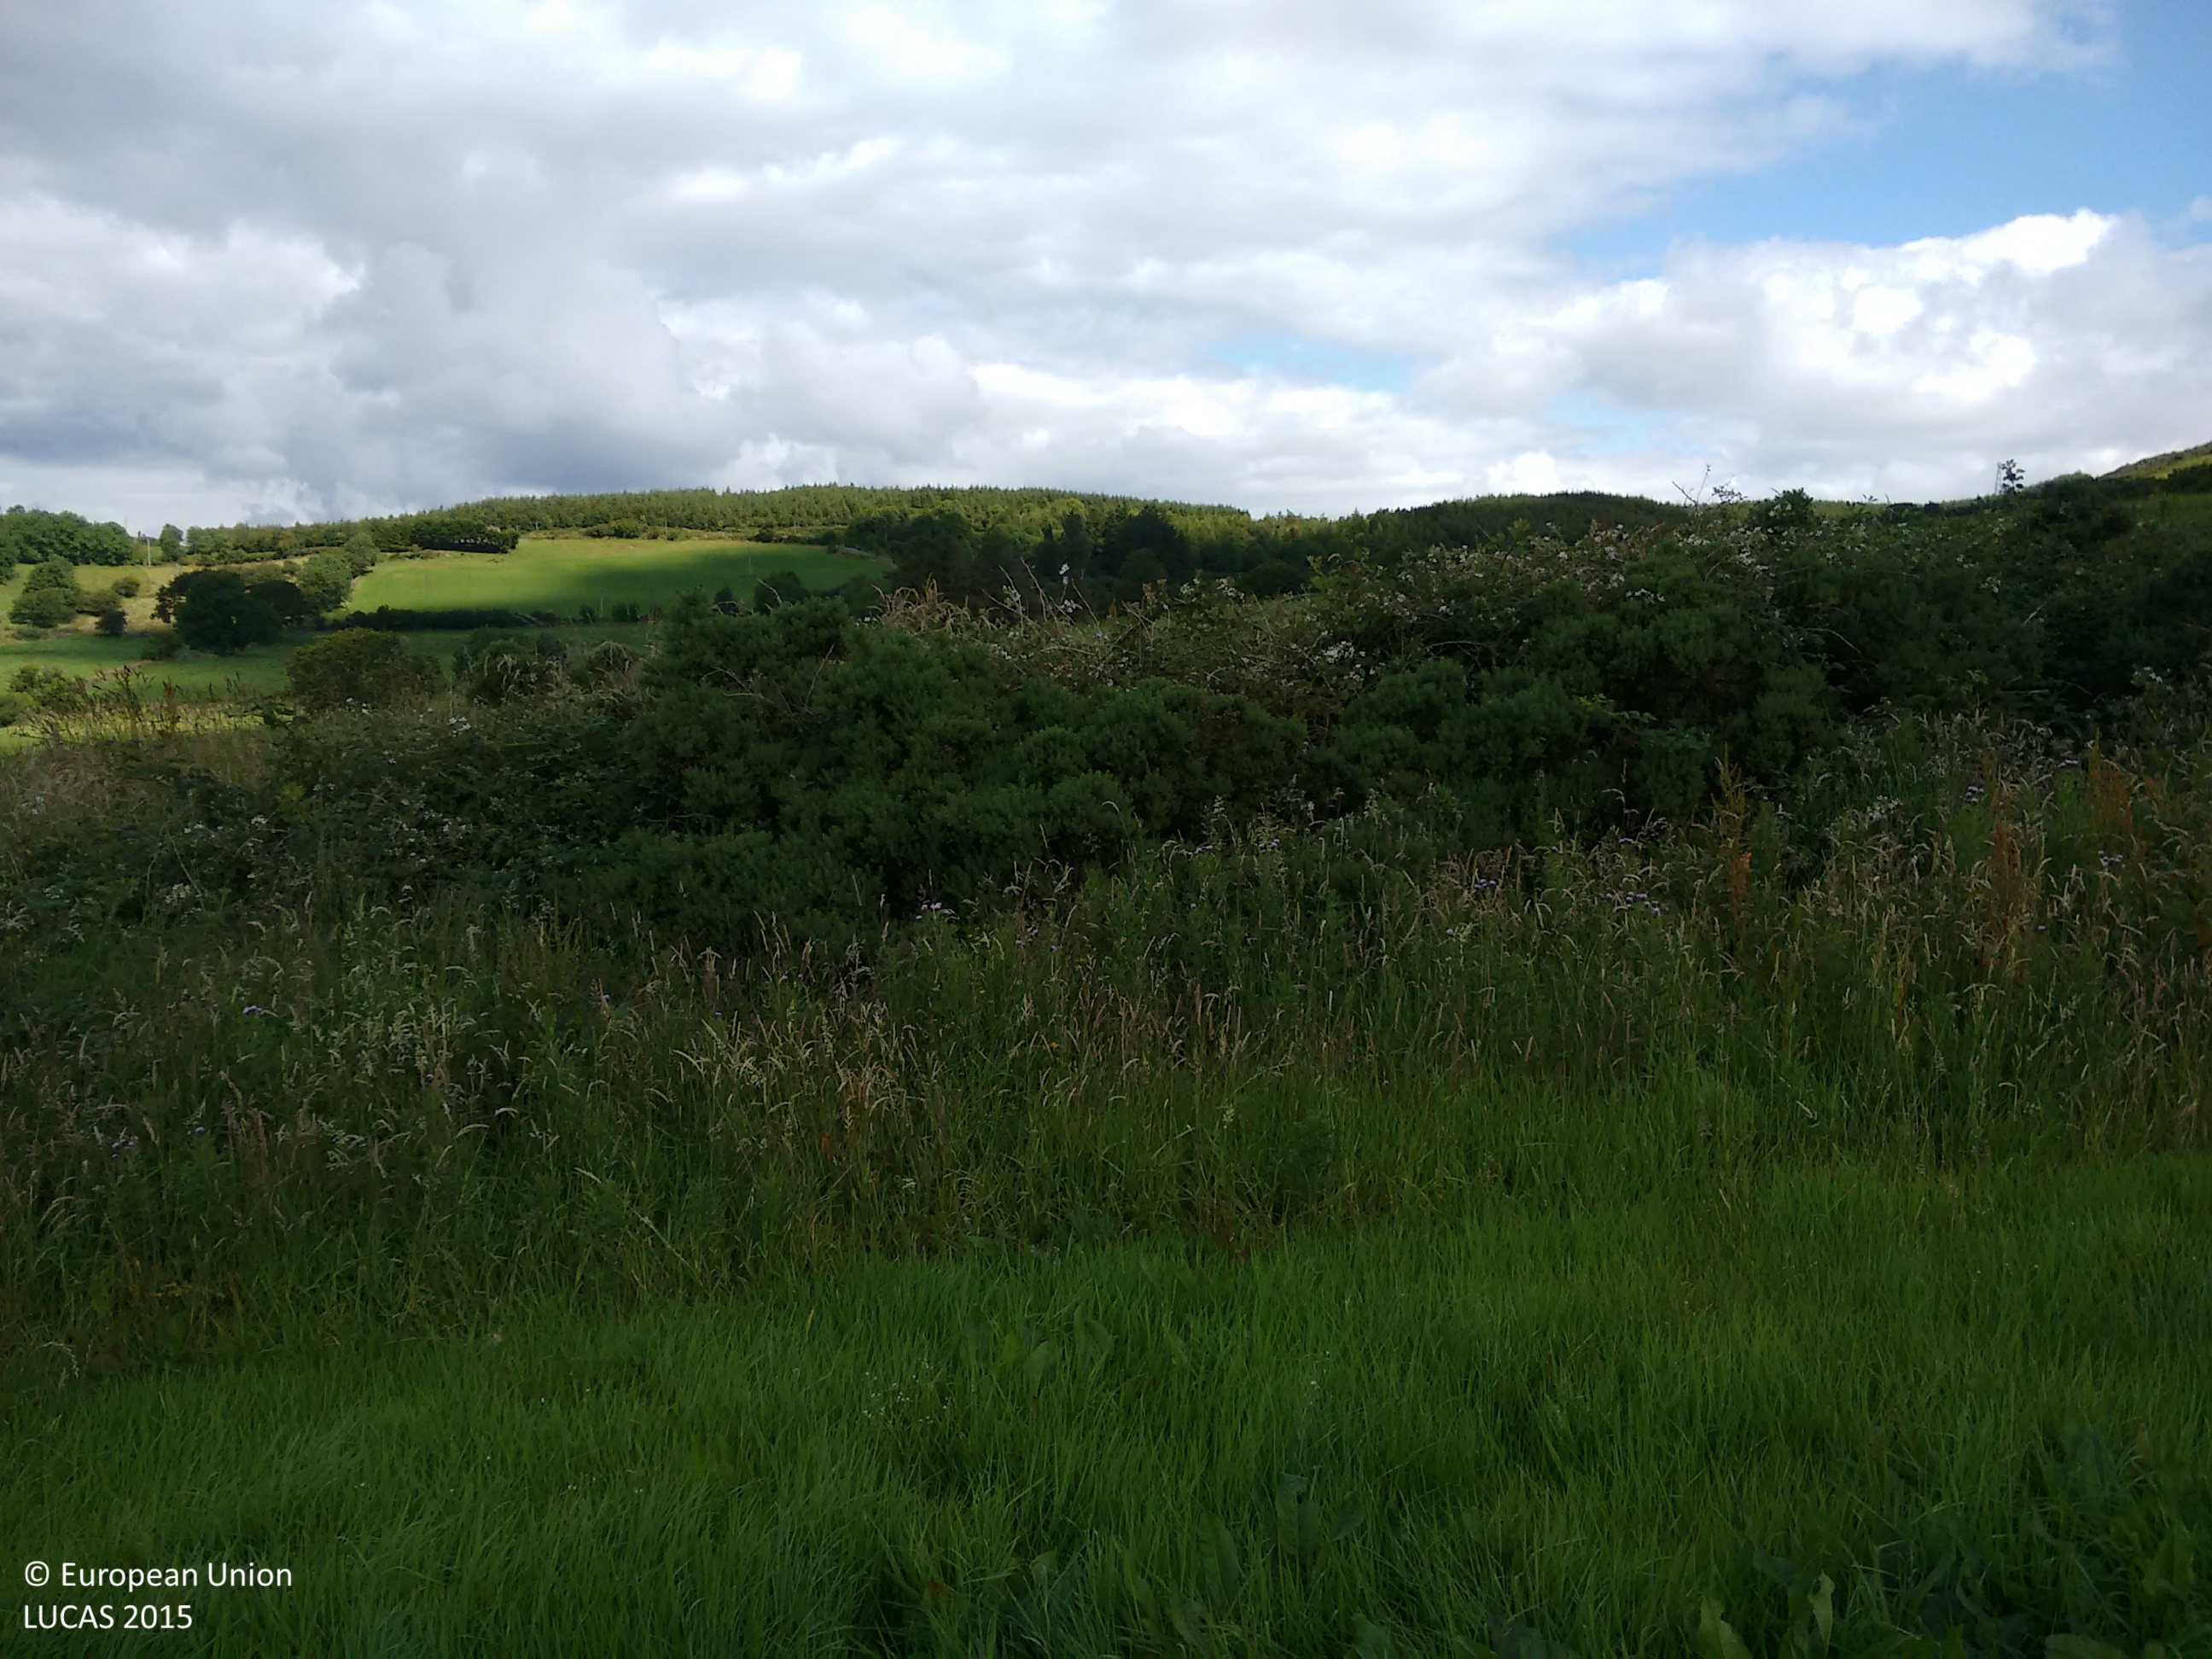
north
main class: Grassland
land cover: Grassland without tree/shrub cover
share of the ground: > 75 %
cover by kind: herbaceous plants 95 %, shrubs 5 %
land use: Agriculture (excluding fallow land and kitchen gardens)
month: July
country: IE
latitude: 52.8407
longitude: -8.4064
